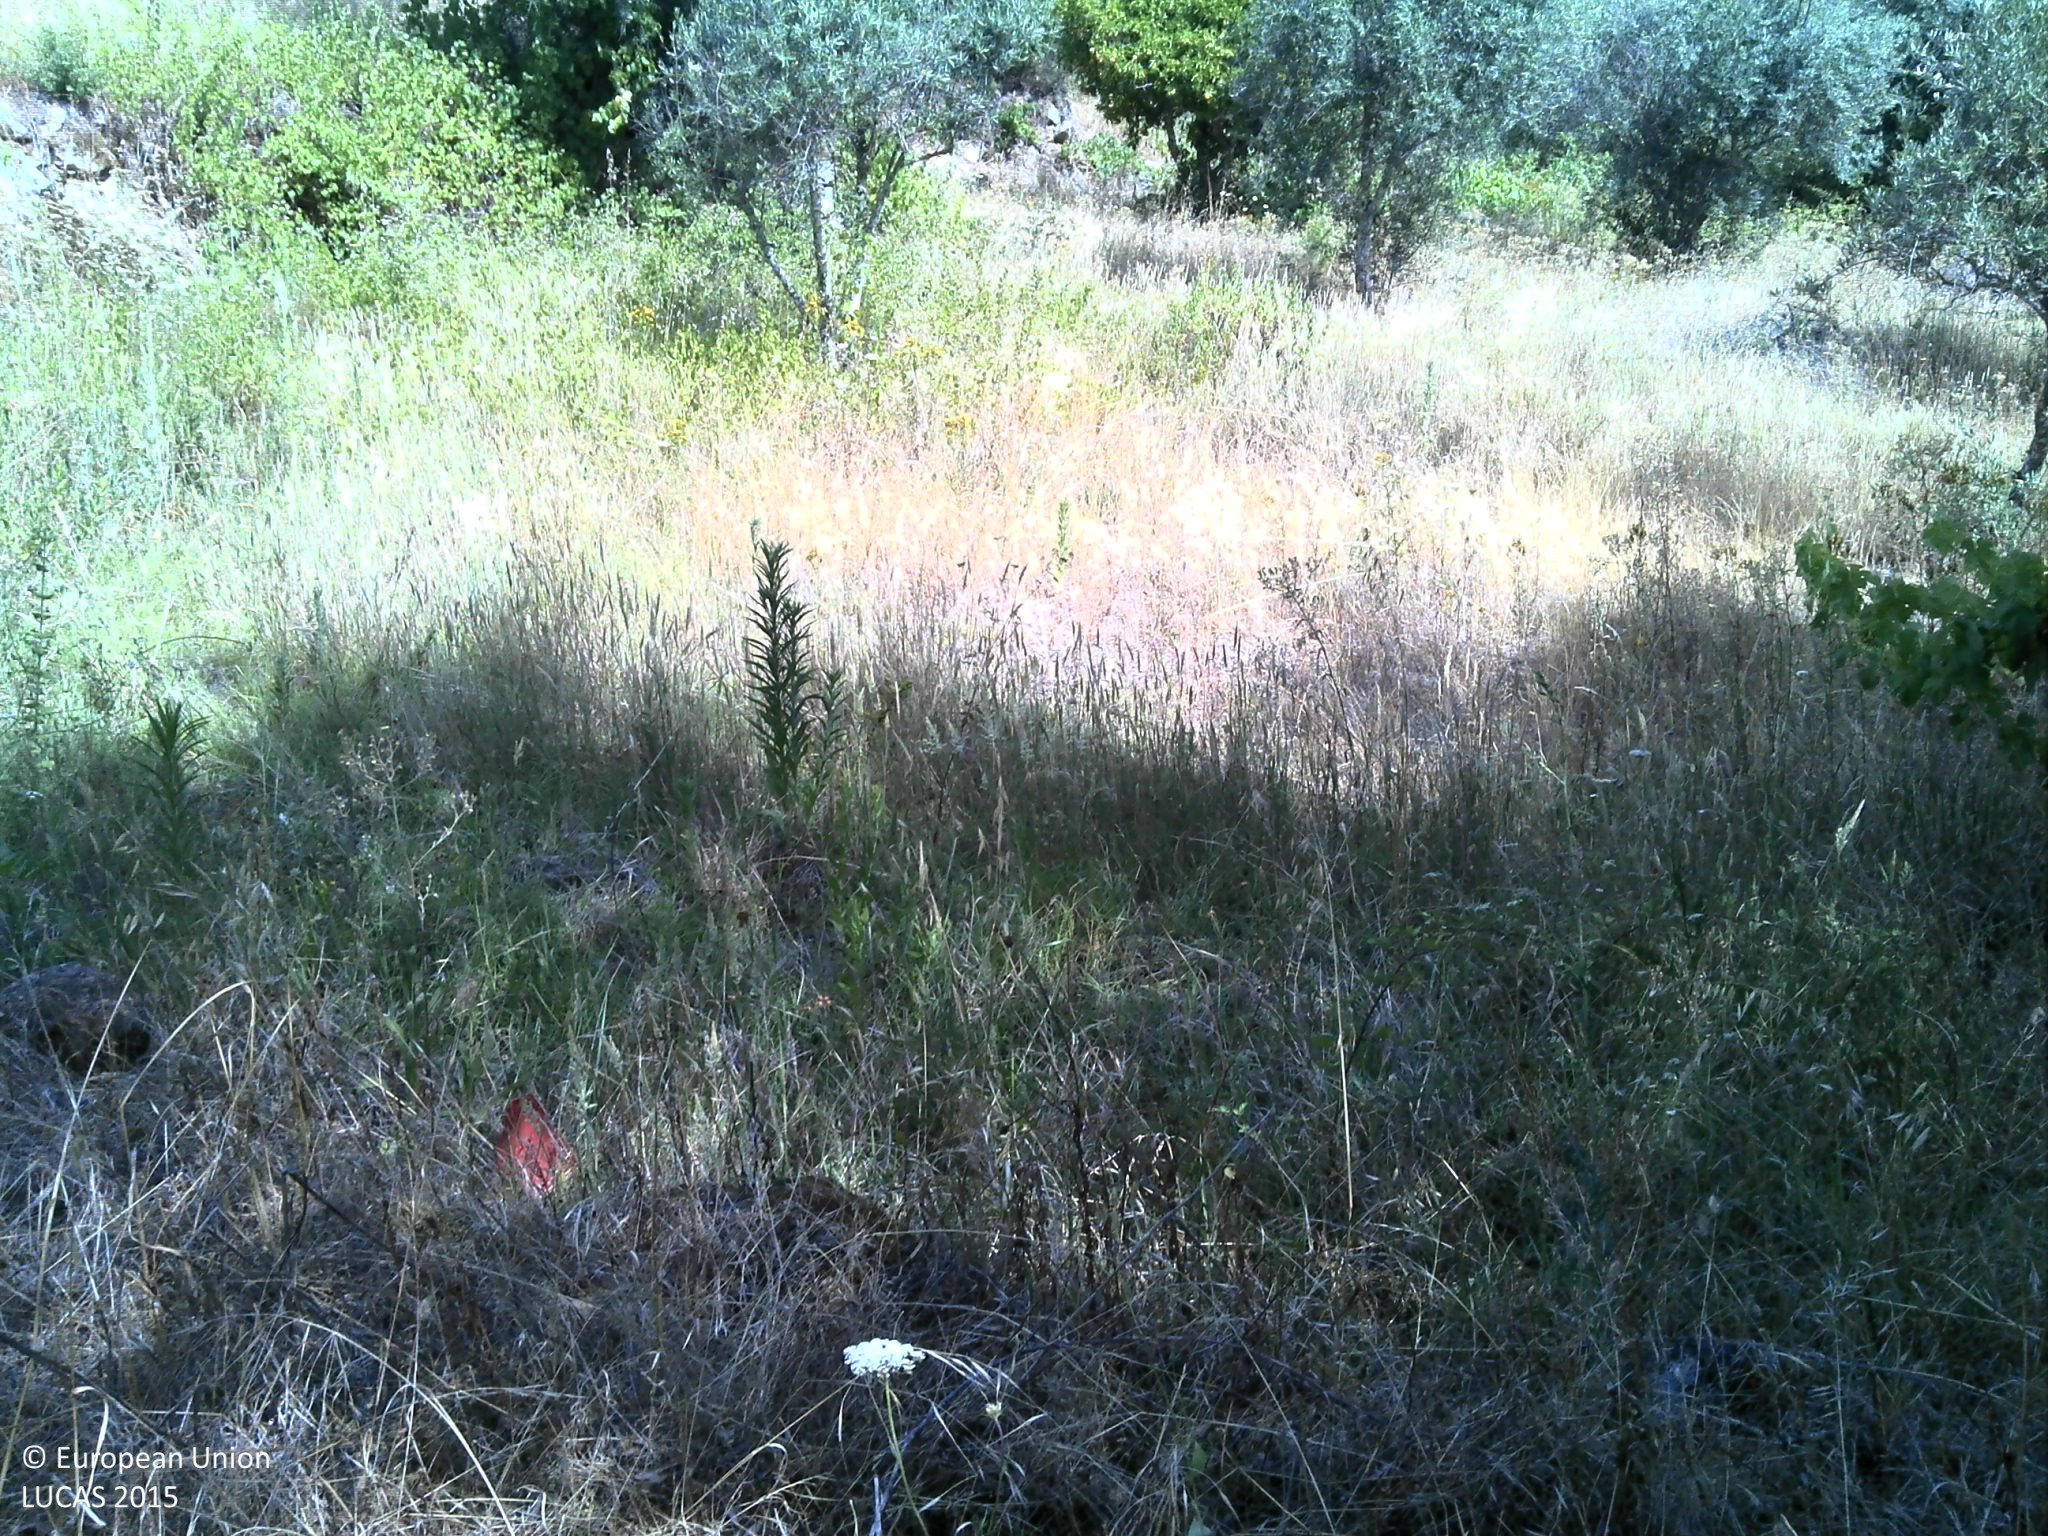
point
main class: Cropland
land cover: Olive groves
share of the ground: < 10 %
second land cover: Grassland without tree/shrub cover
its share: > 75 %
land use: Agriculture (excluding fallow land and kitchen gardens)
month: July
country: PT
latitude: 39.5233
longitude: -8.0332
